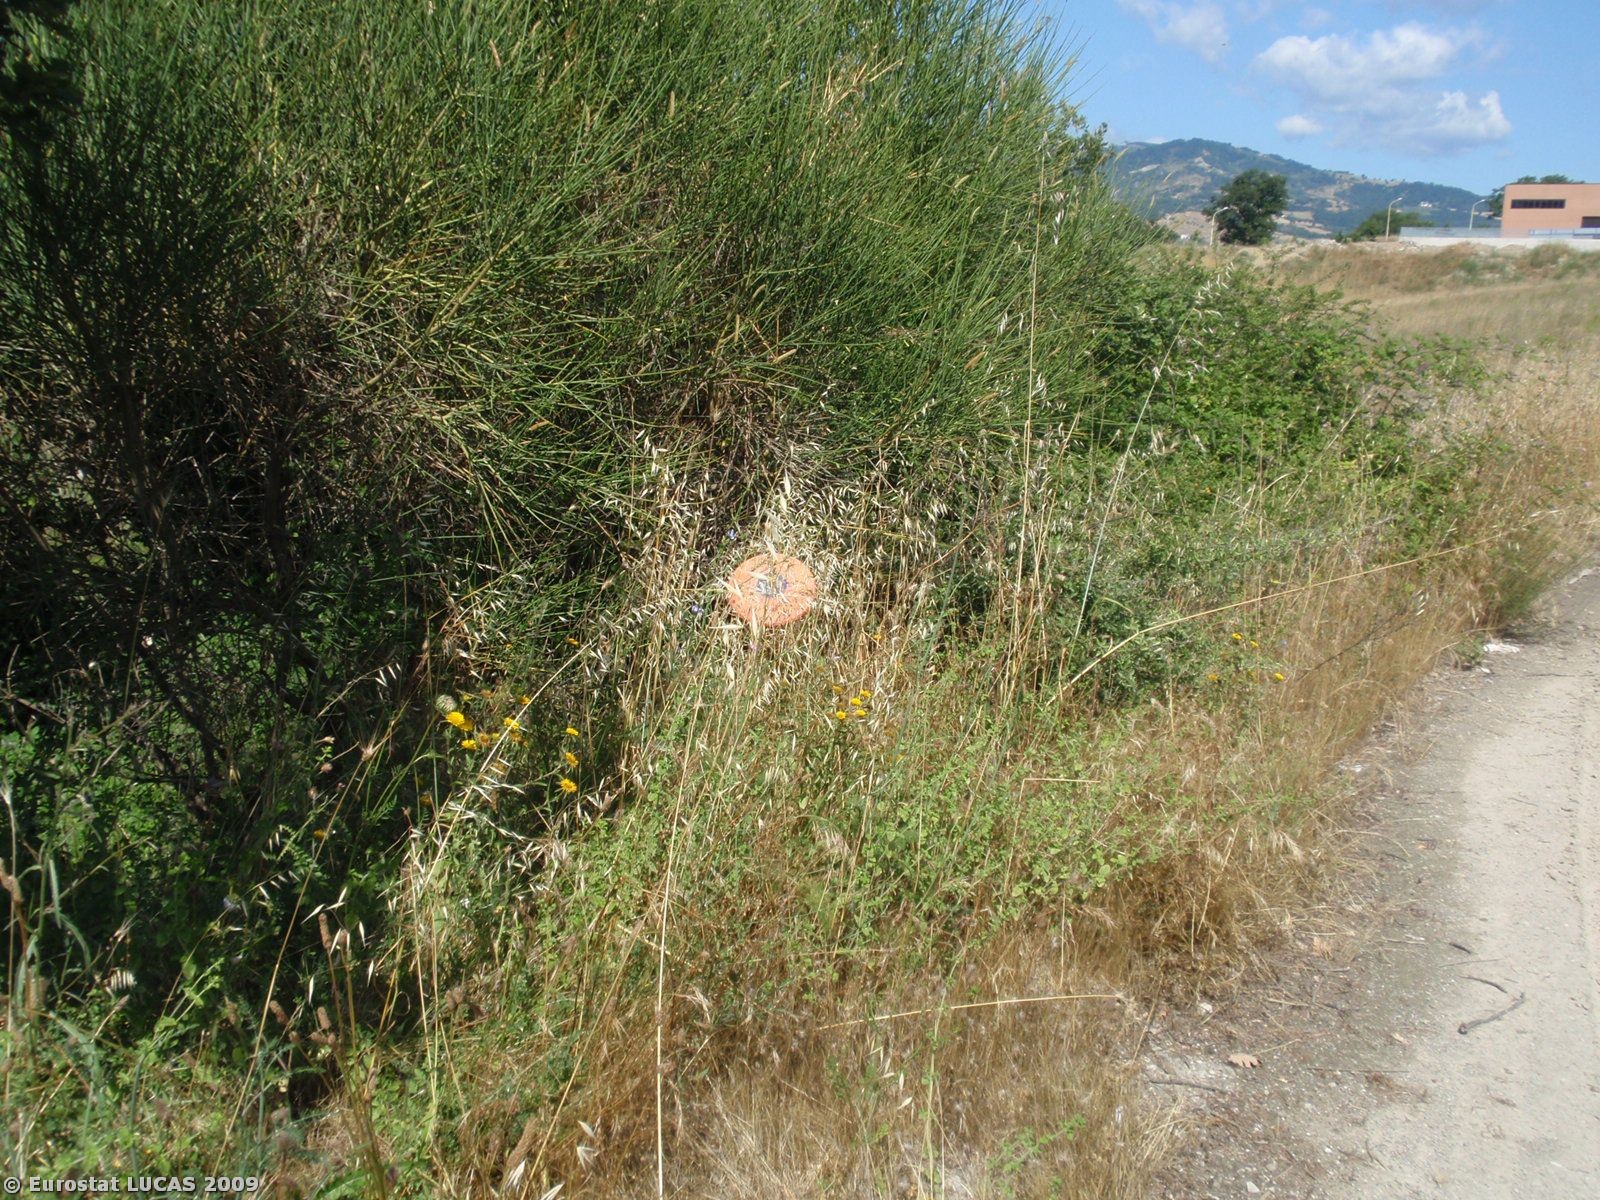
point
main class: Shrubland
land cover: Shrubland with sparse tree cover
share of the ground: > 75 %
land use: Unused
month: June
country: IT
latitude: 40.3504
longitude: 16.0862
